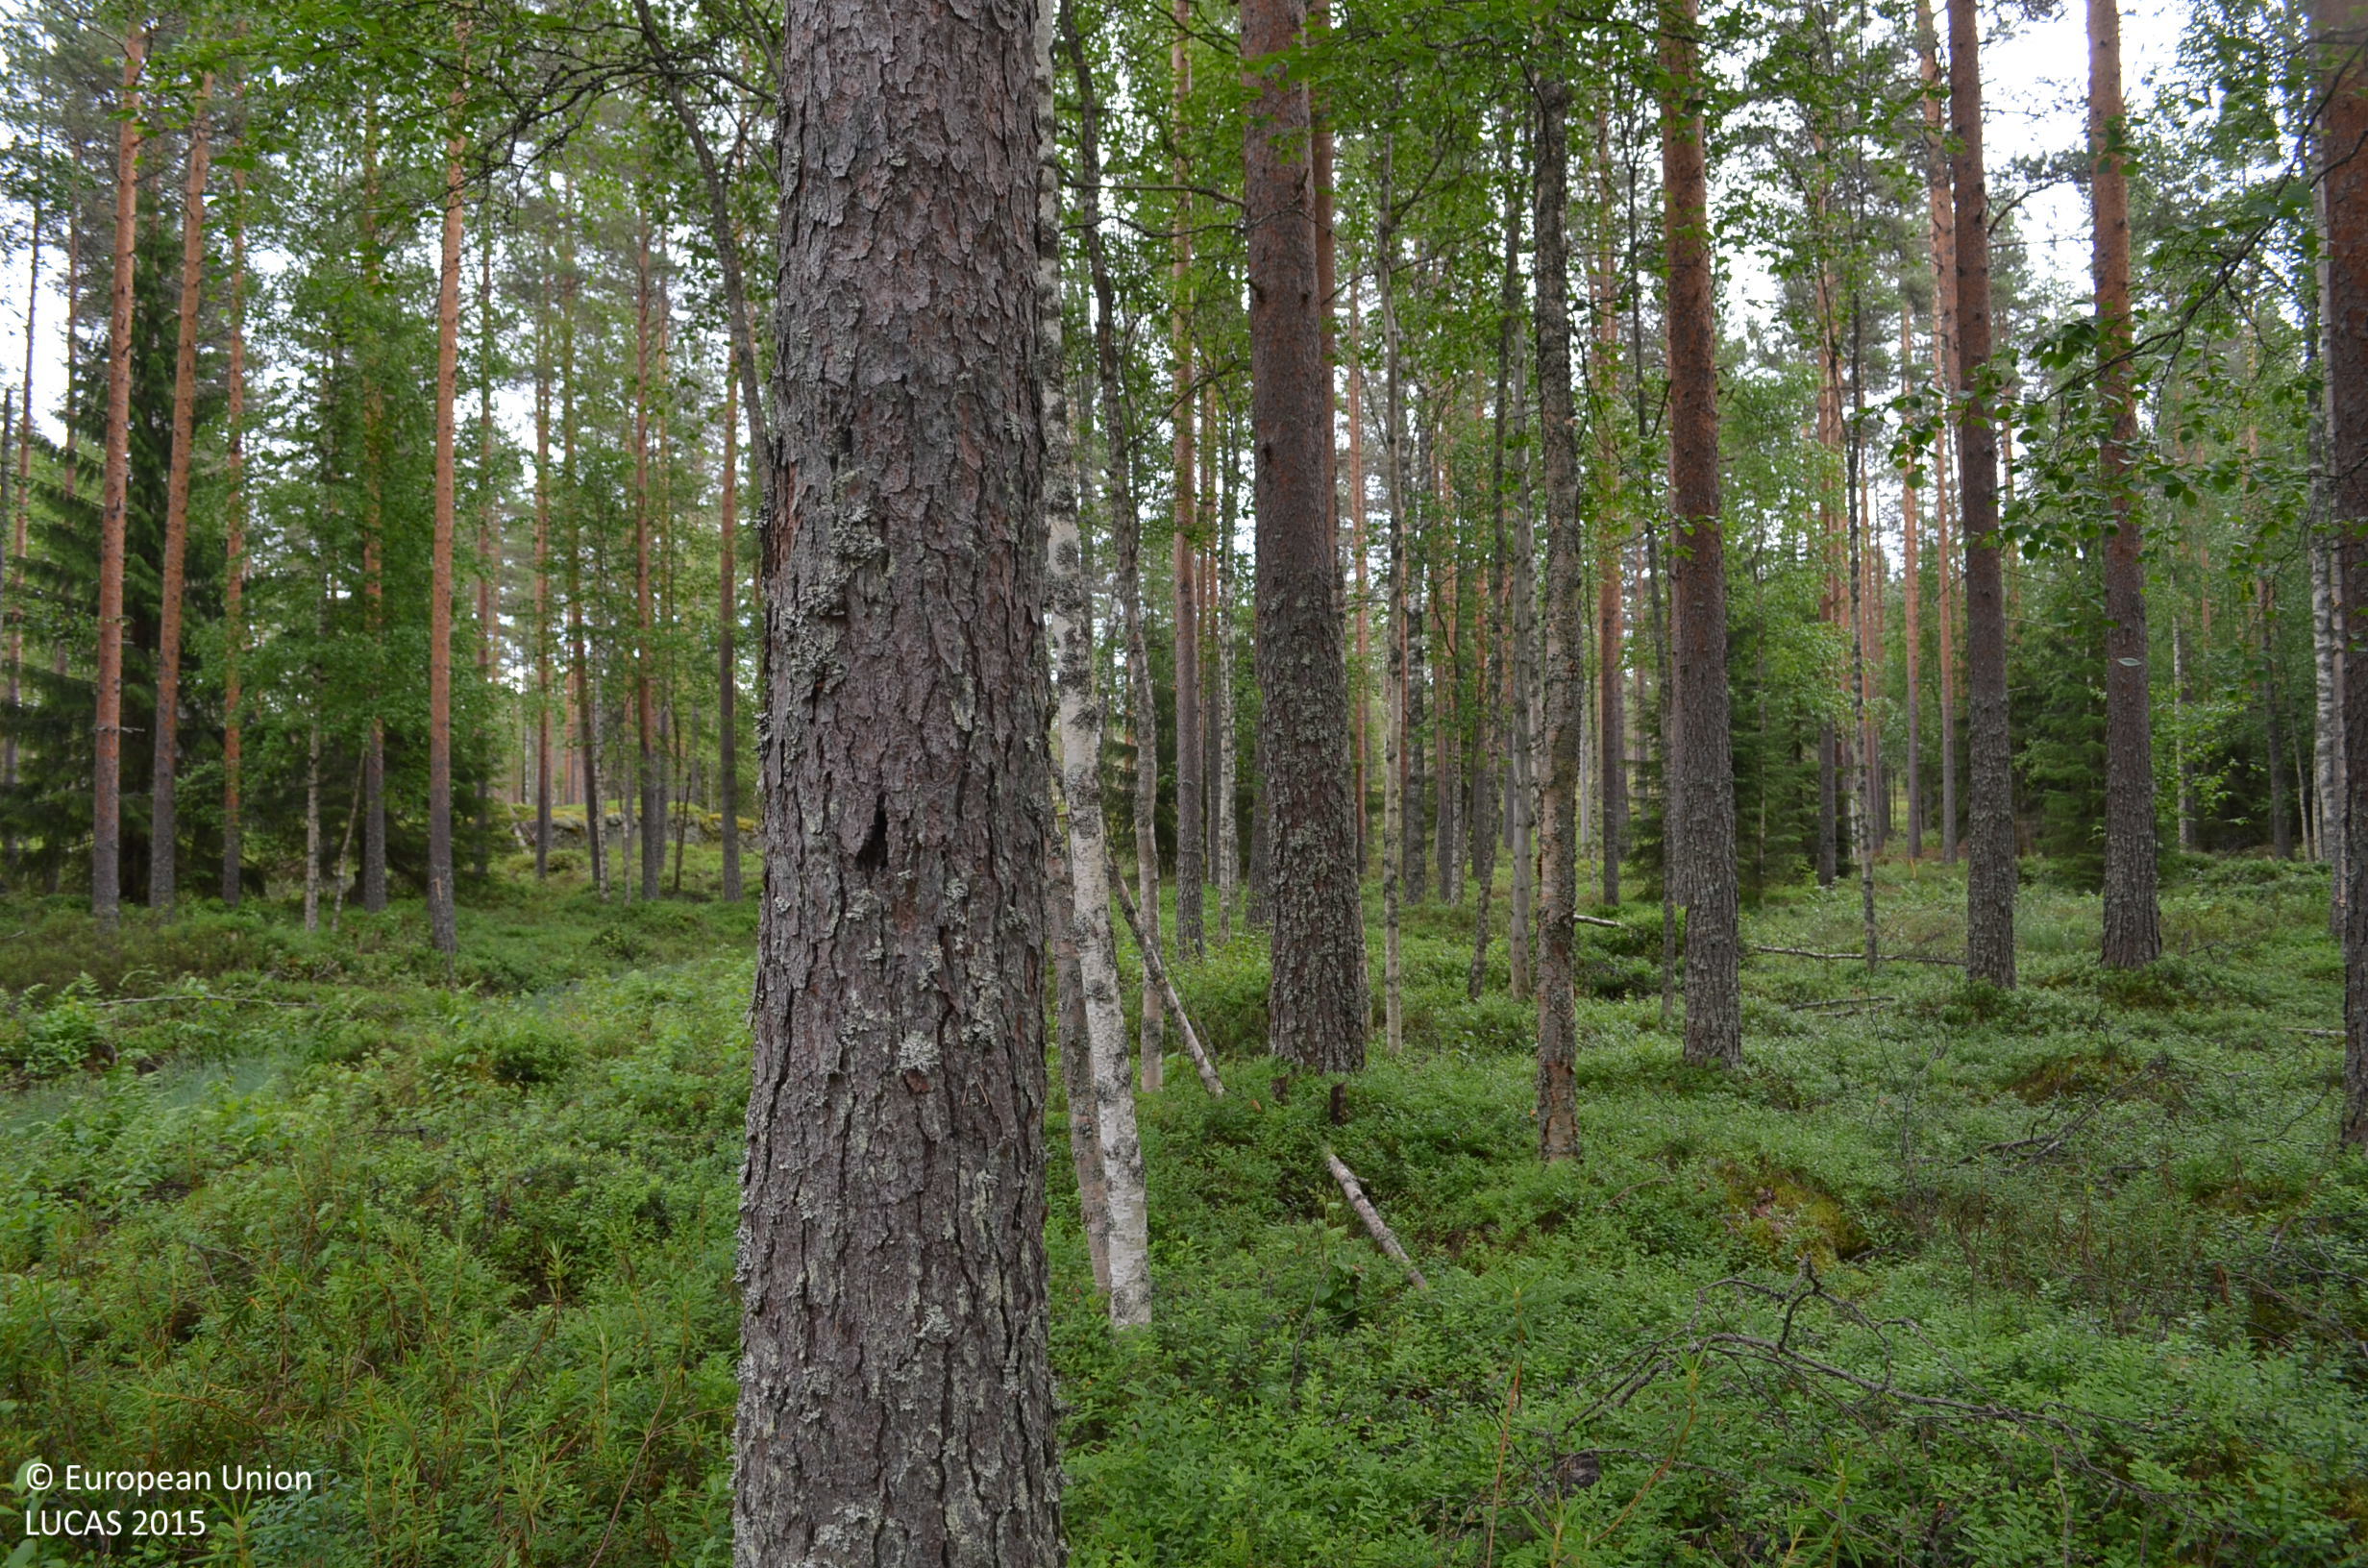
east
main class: Woodland
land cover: Pine dominated mixed woodland
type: boreal forest
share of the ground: > 75 %
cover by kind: coniferous forest trees 55 %, shrubs 25 %, broadleaved forest trees 20 %
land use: Forestry
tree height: > 5 m
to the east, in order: Pine dominated mixed woodland; Ditches and canals; Pine dominated mixed woodland; Ditches and canals; Pine dominated coniferous woodland; Tracks; Pine dominated mixed woodland
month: July
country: FI
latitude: 62.2511
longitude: 23.5704
